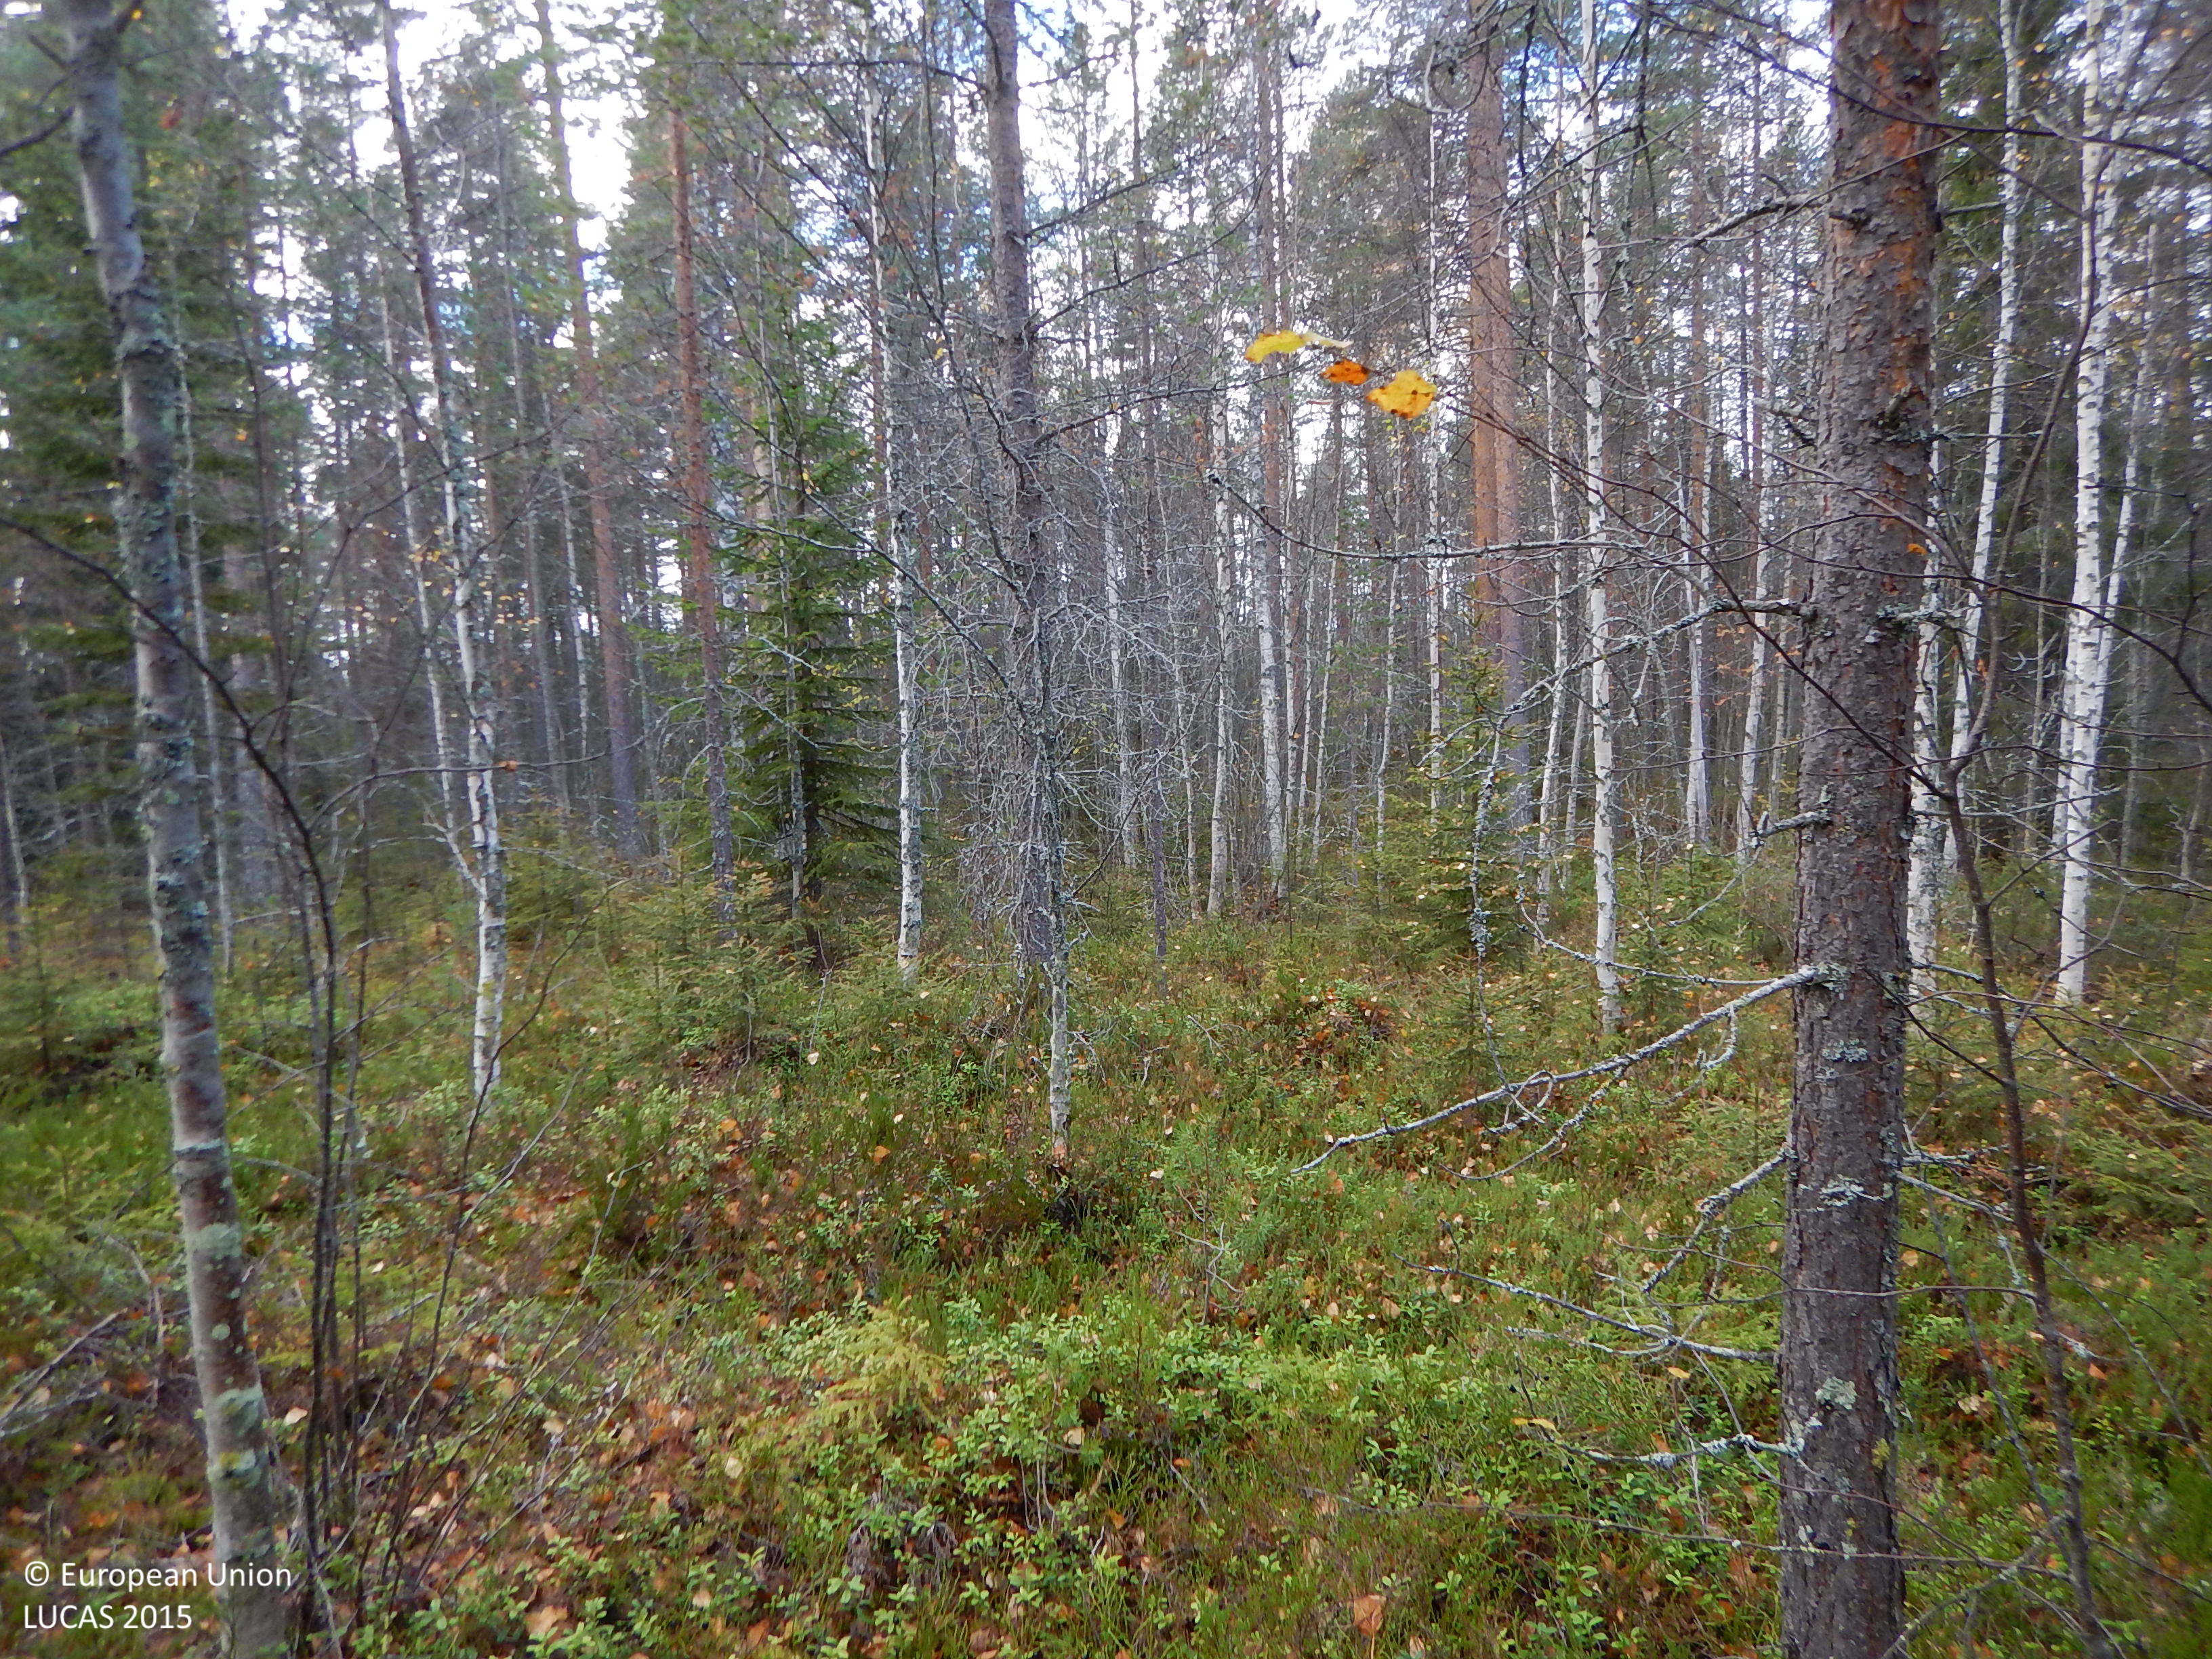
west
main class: Woodland
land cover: Pine dominated mixed woodland
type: boreal forest
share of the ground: 50 - 75 %
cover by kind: coniferous forest trees 45 %, broadleaved forest trees 20 %, shrubs 15 %, herbaceous plants 10 %, lichens and mosses 10 %
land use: Forestry
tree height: > 5 m
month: October
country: SE
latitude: 65.0918
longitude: 21.0191
